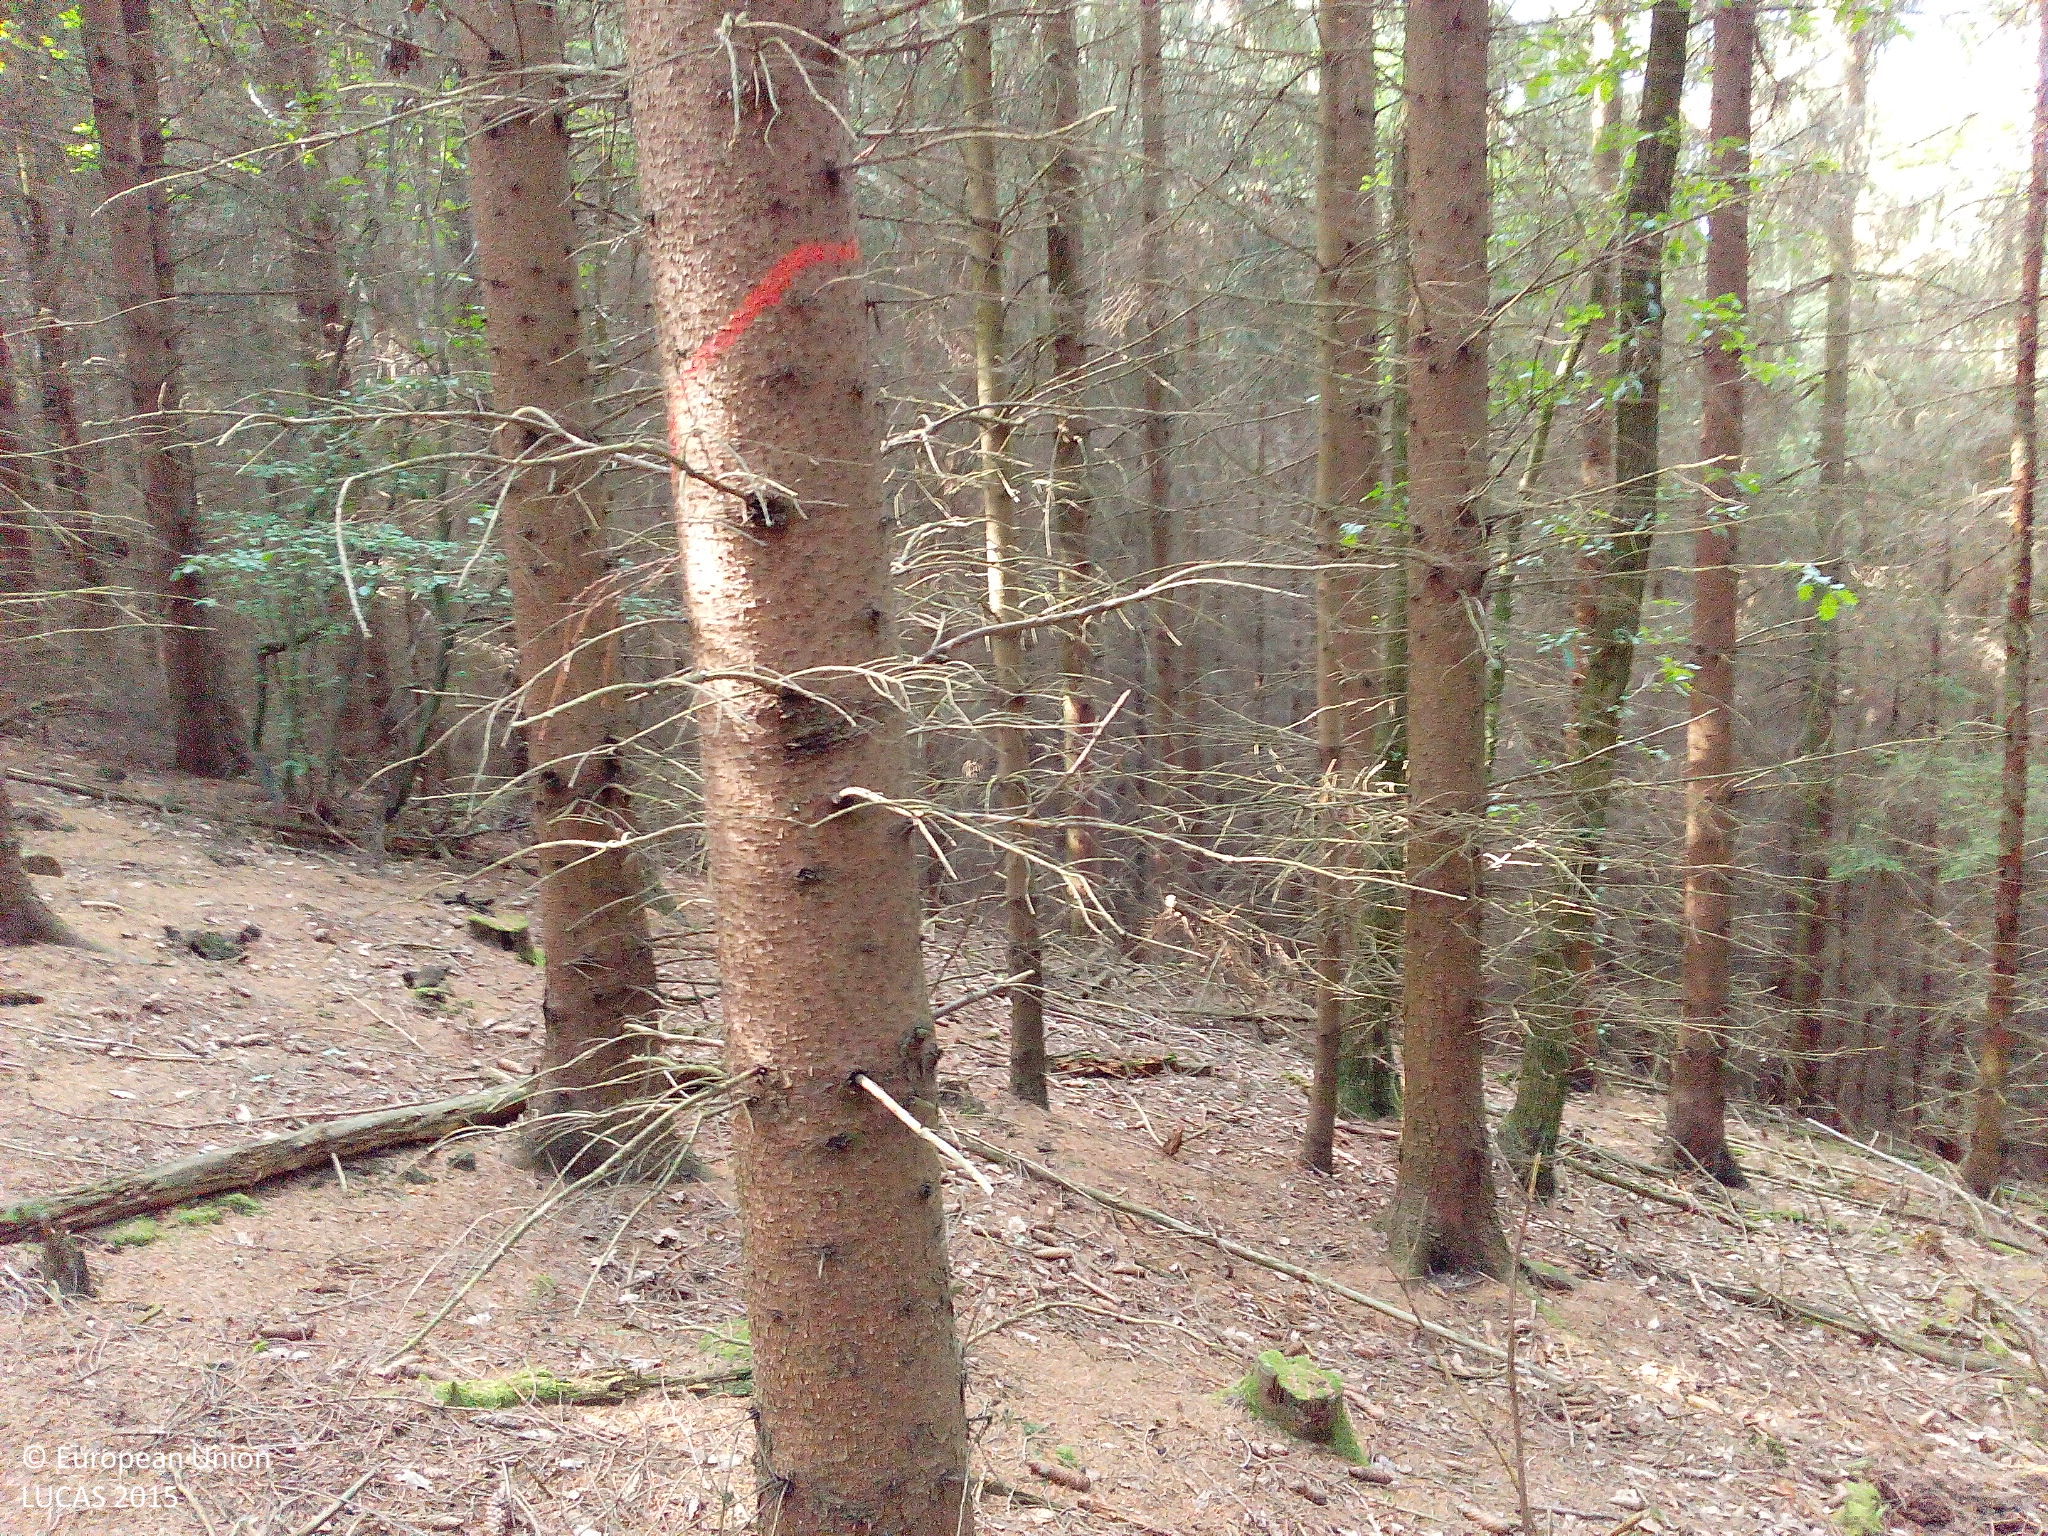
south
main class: Woodland
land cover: Spruce dominated coniferous woodland
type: hemiboreal forest and nemoral coniferous forest and mixed broadleaved-coniferous forest
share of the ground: > 75 %
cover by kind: coniferous forest trees 95 %, unconsolidated bare surface 5 %
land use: Forestry
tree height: > 5 m
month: July
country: DE
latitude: 51.0832
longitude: 9.9572
